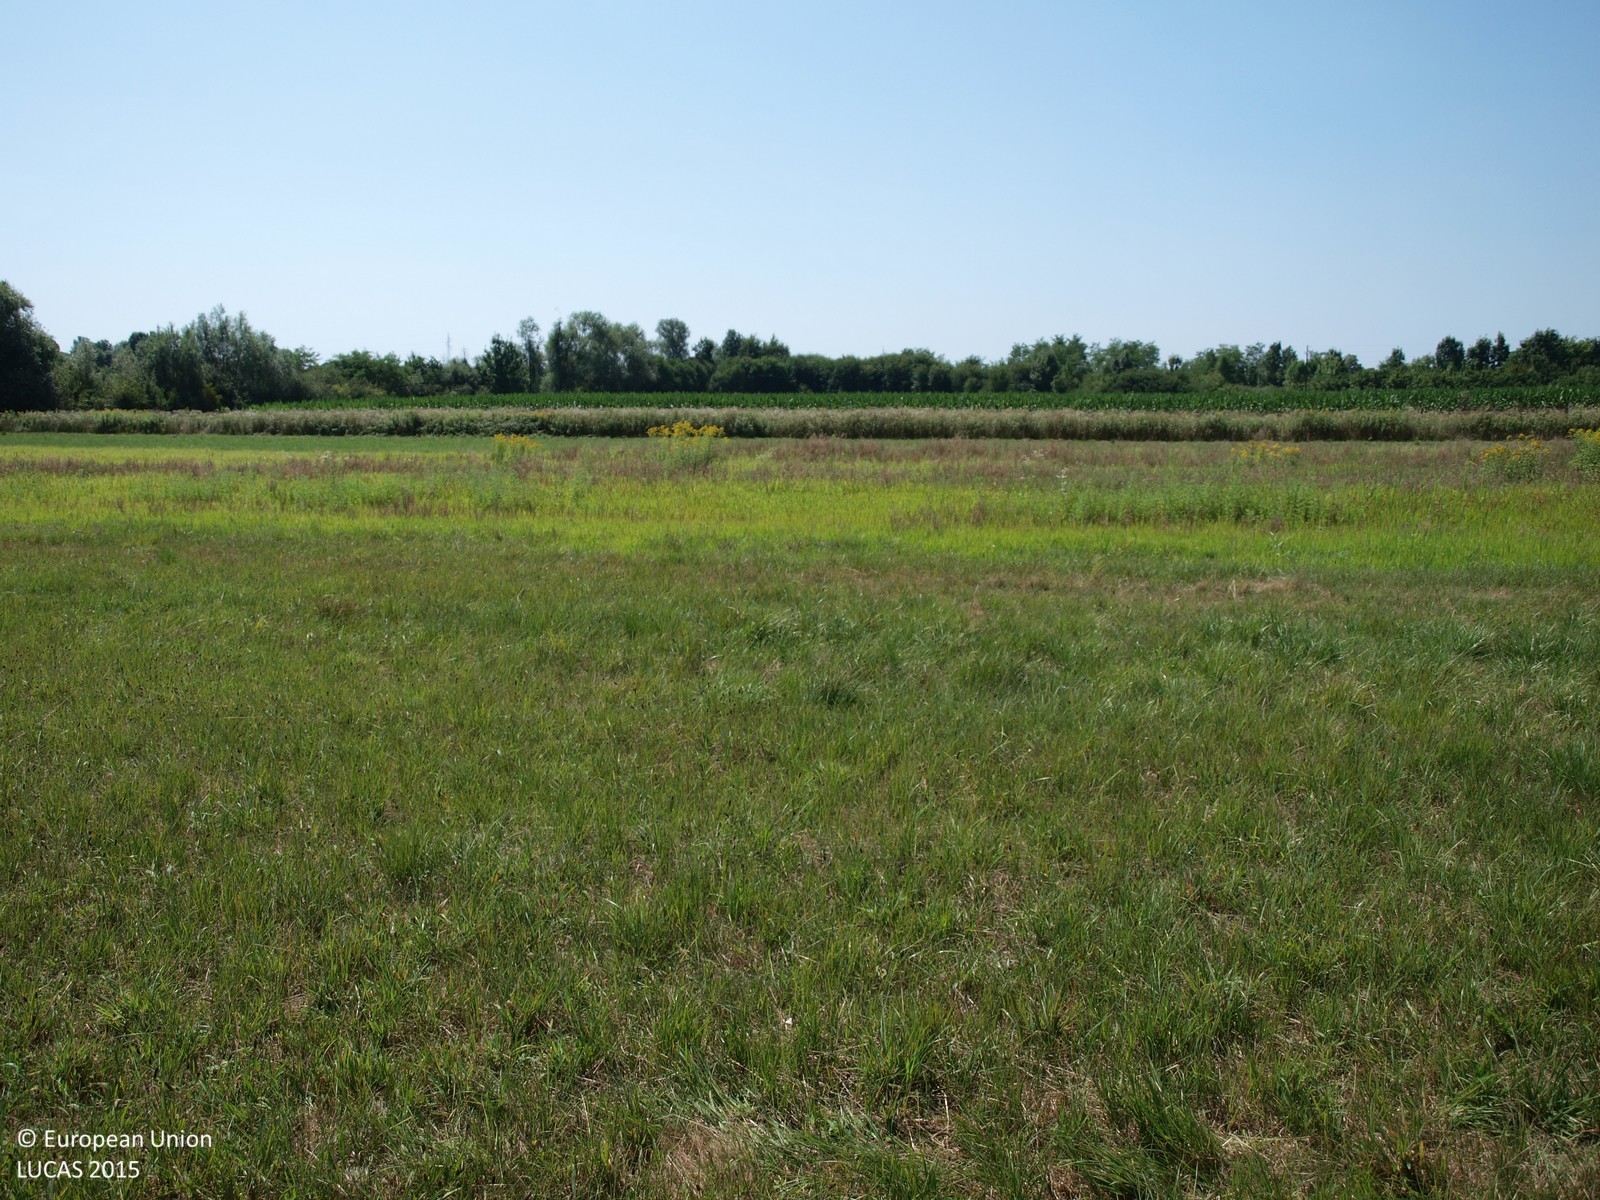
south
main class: Grassland
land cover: Grassland without tree/shrub cover
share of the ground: > 75 %
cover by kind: herbaceous plants 100 %
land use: Agriculture (excluding fallow land and kitchen gardens)
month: August
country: HR
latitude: 45.8749
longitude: 16.3246
